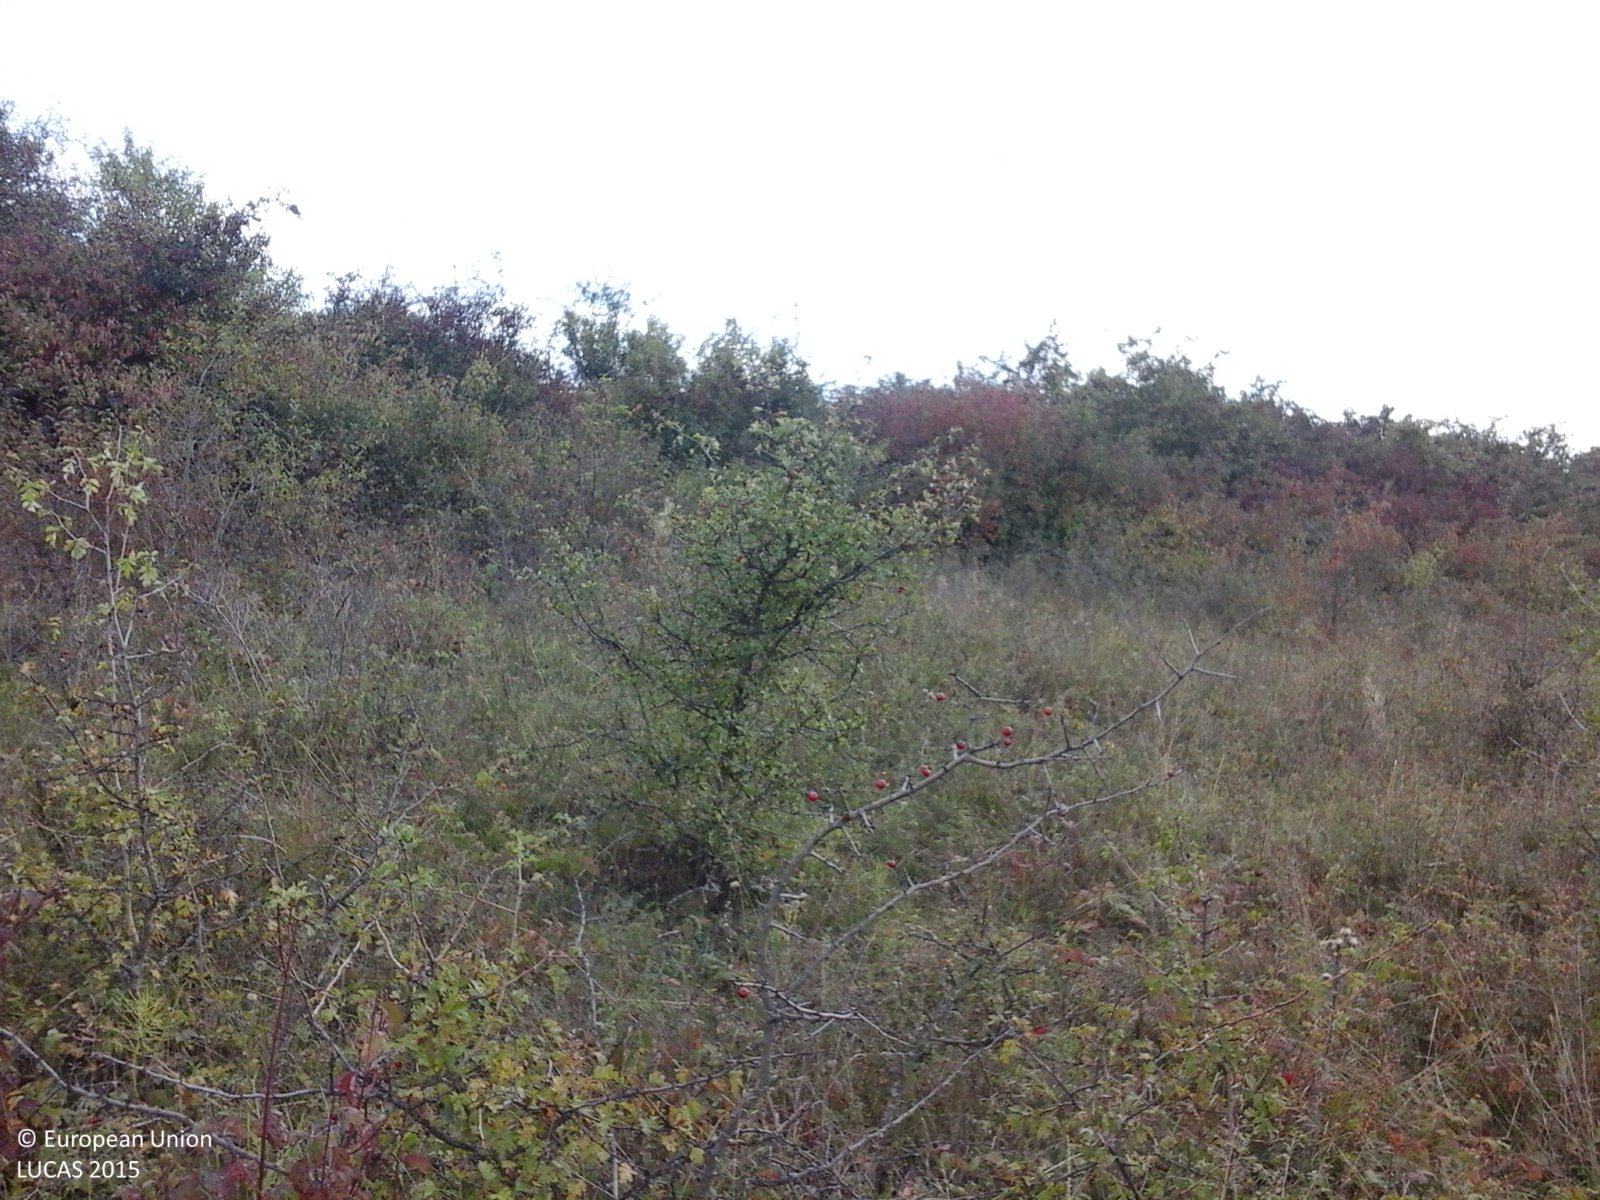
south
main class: Grassland
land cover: Grassland with sparse tree/shrub cover
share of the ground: > 75 %
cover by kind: herbaceous plants 85 %, shrubs 10 %, broadleaved forest trees 5 %
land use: Fallow land
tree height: < 5 m
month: October
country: RO
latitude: 46.3834
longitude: 24.3466
